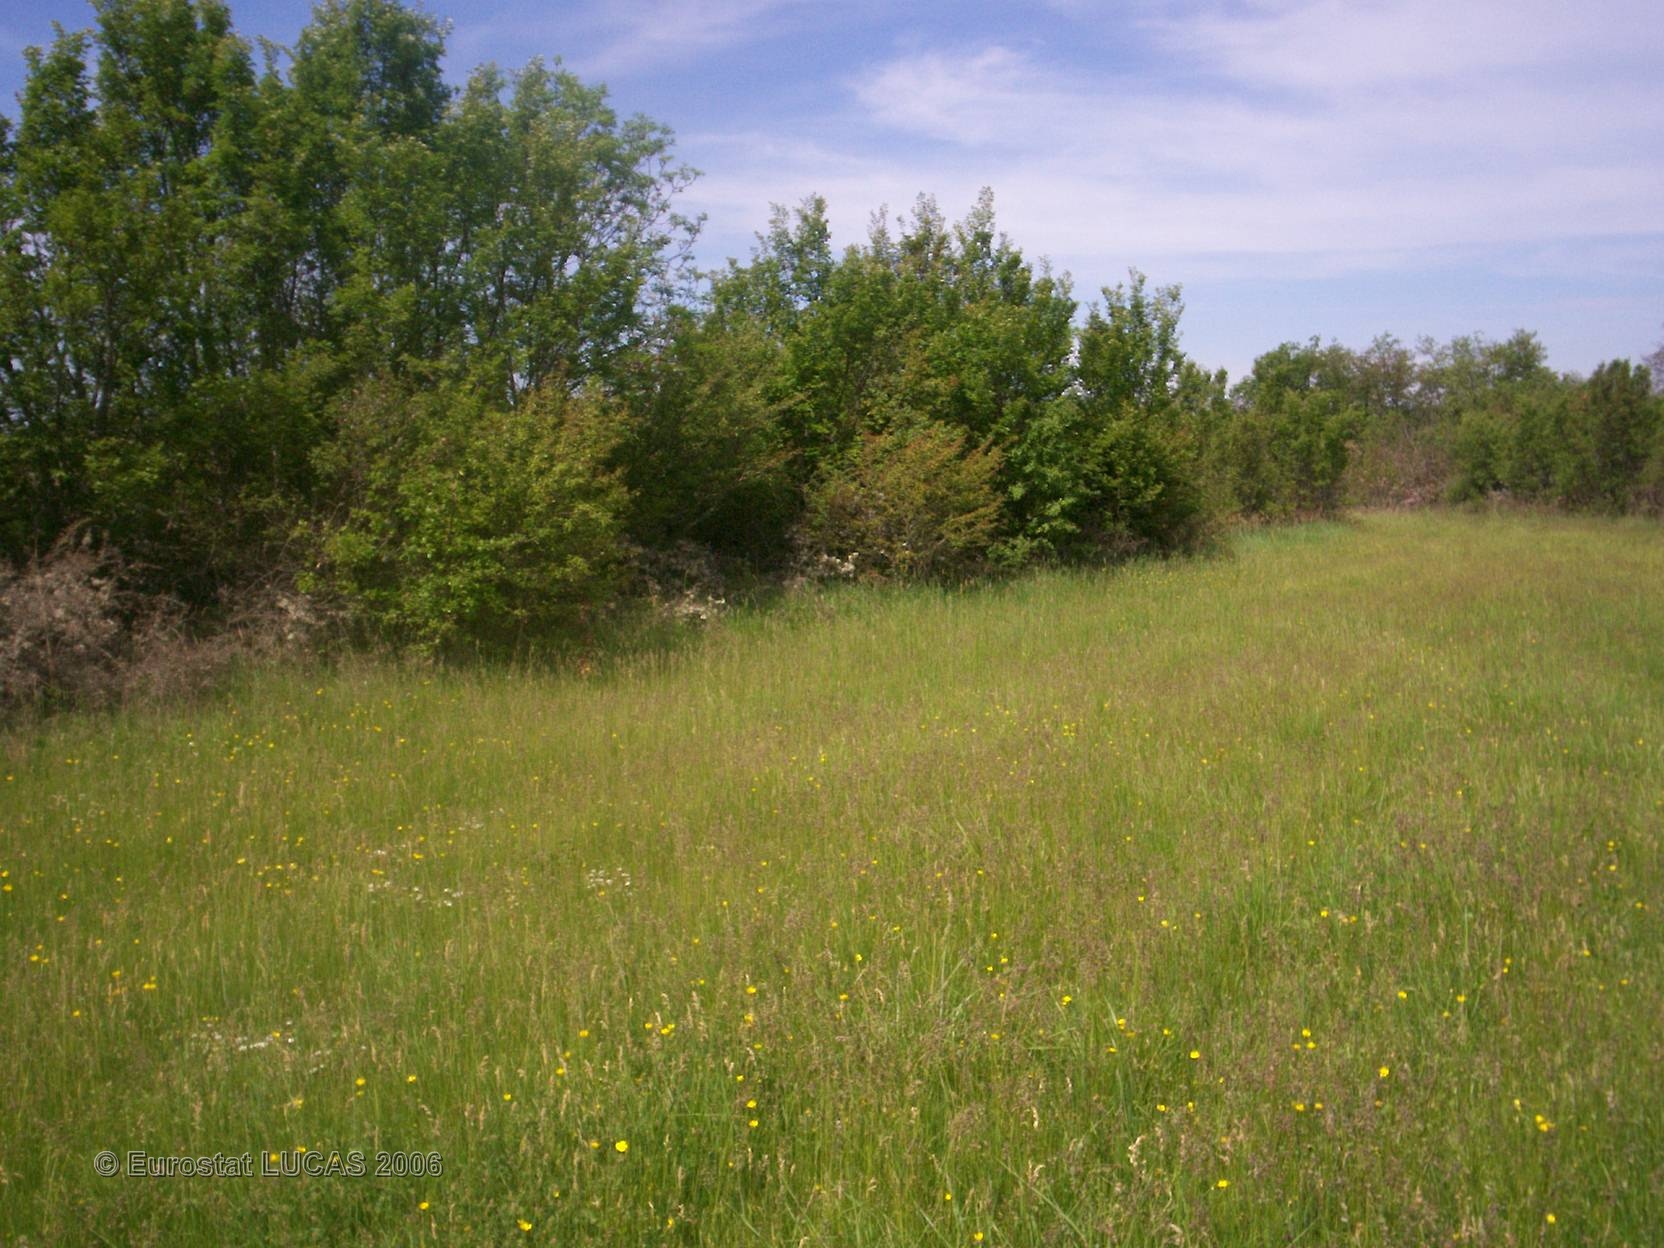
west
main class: Grassland
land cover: Grassland without tree/shrub cover
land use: Agriculture (excluding fallow land and kitchen gardens)
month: May
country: FR
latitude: 45.5040
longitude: 3.2306
